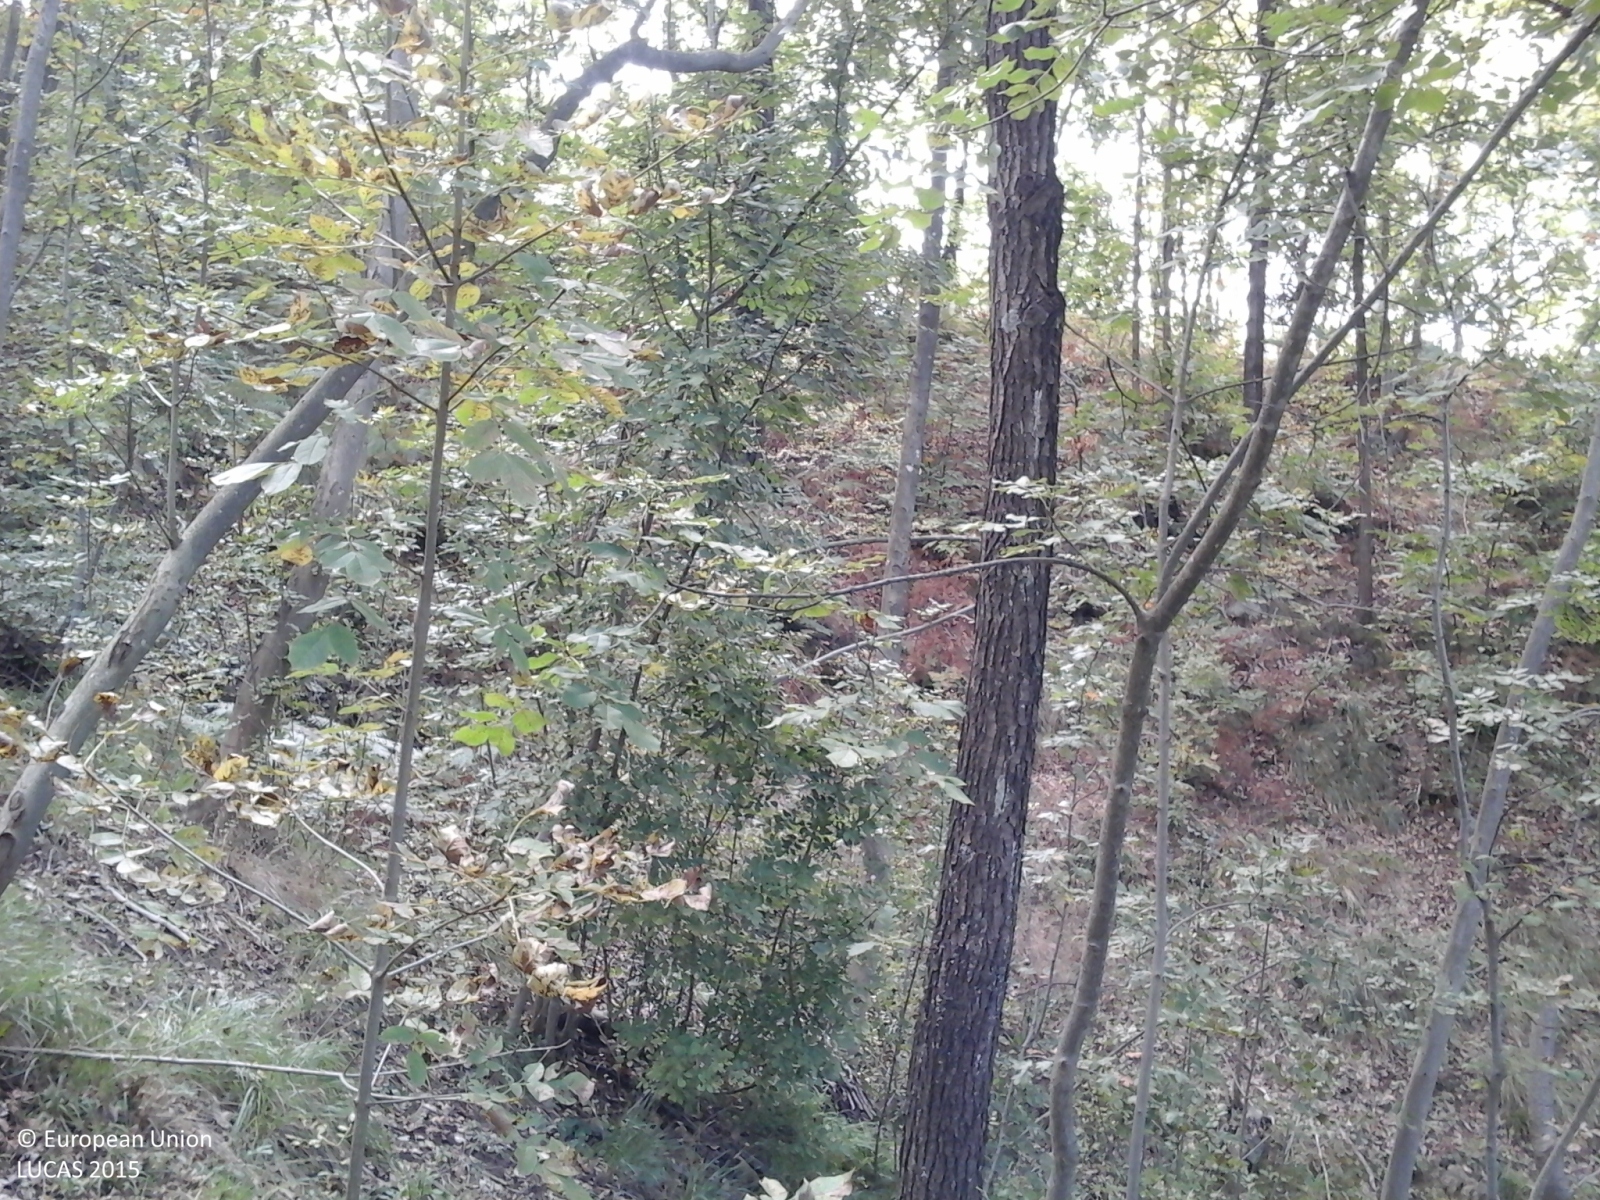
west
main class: Woodland
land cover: Broadleaved woodland
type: thermophilous deciduous forest
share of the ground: > 75 %
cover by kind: broadleaved forest trees 70 %, herbaceous plants 20 %, shrubs 10 %
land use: Forestry
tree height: > 5 m
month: September
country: IT
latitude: 44.4466
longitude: 8.4077
